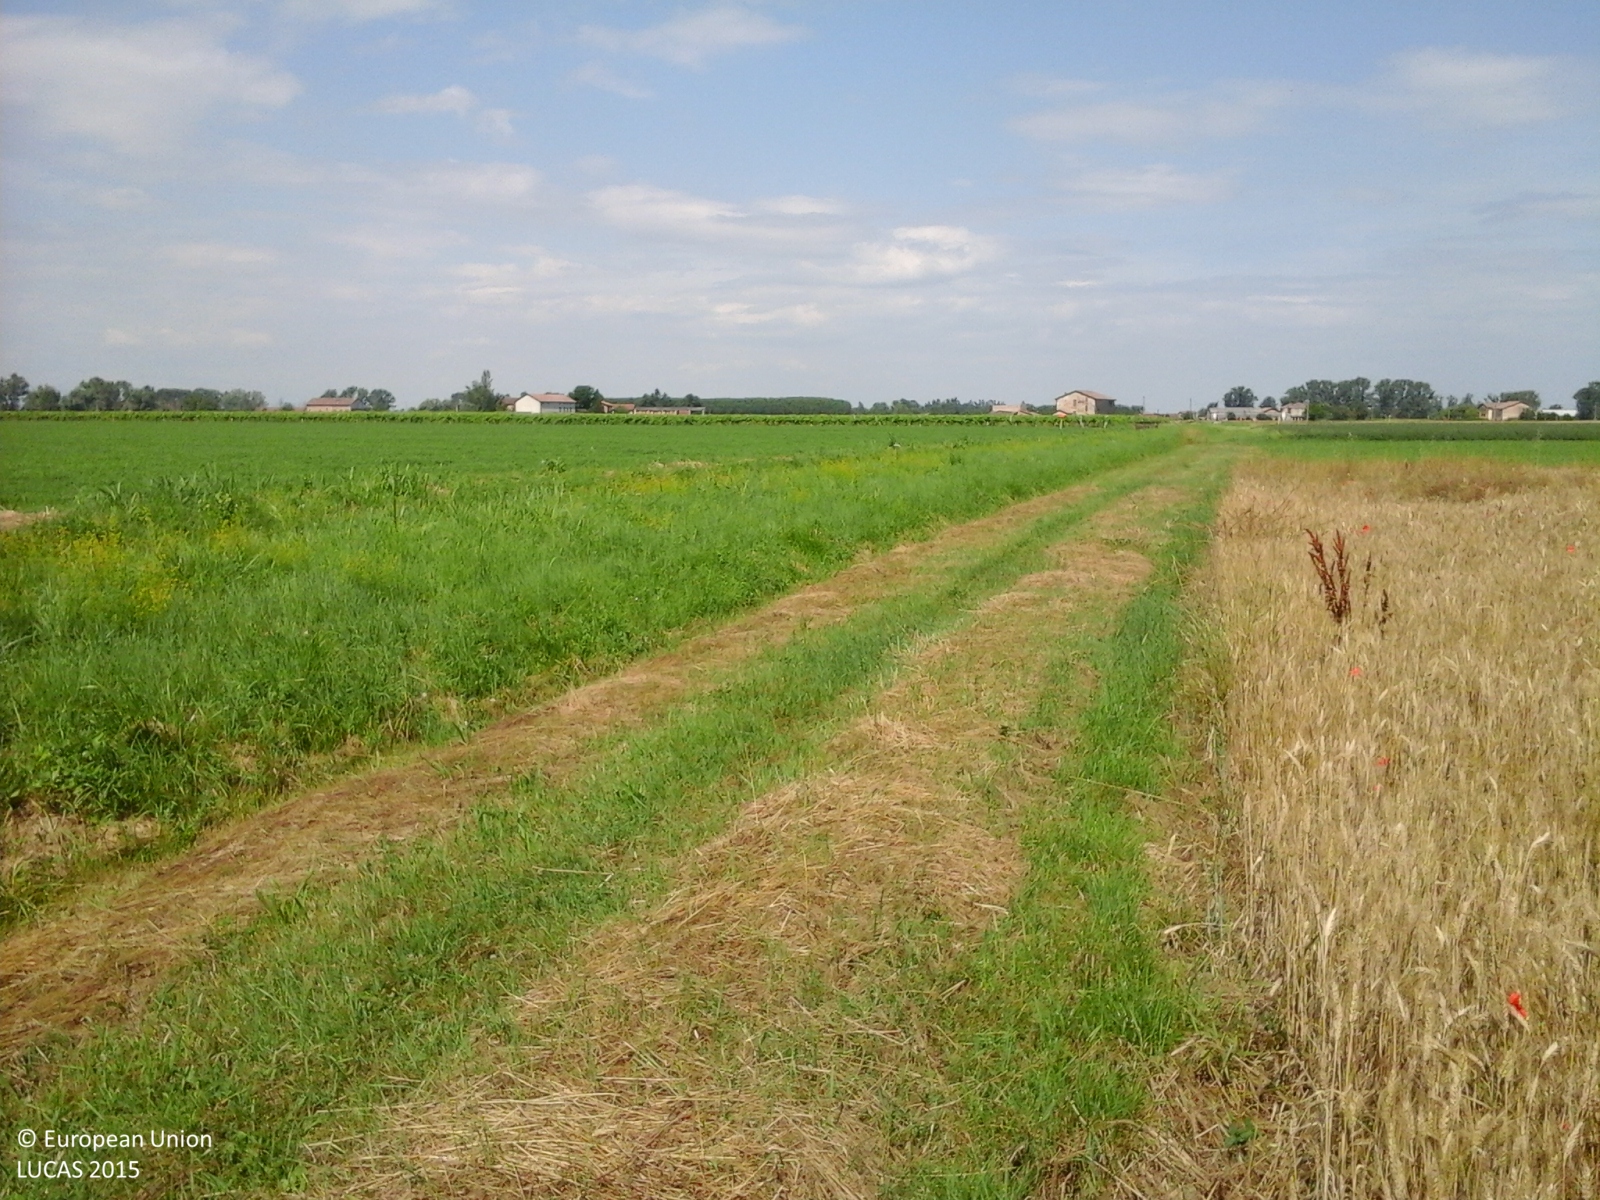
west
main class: Cropland
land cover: Durum wheat
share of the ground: > 75 %
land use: Agriculture (excluding fallow land and kitchen gardens)
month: June
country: IT
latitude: 44.7266
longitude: 10.7434
